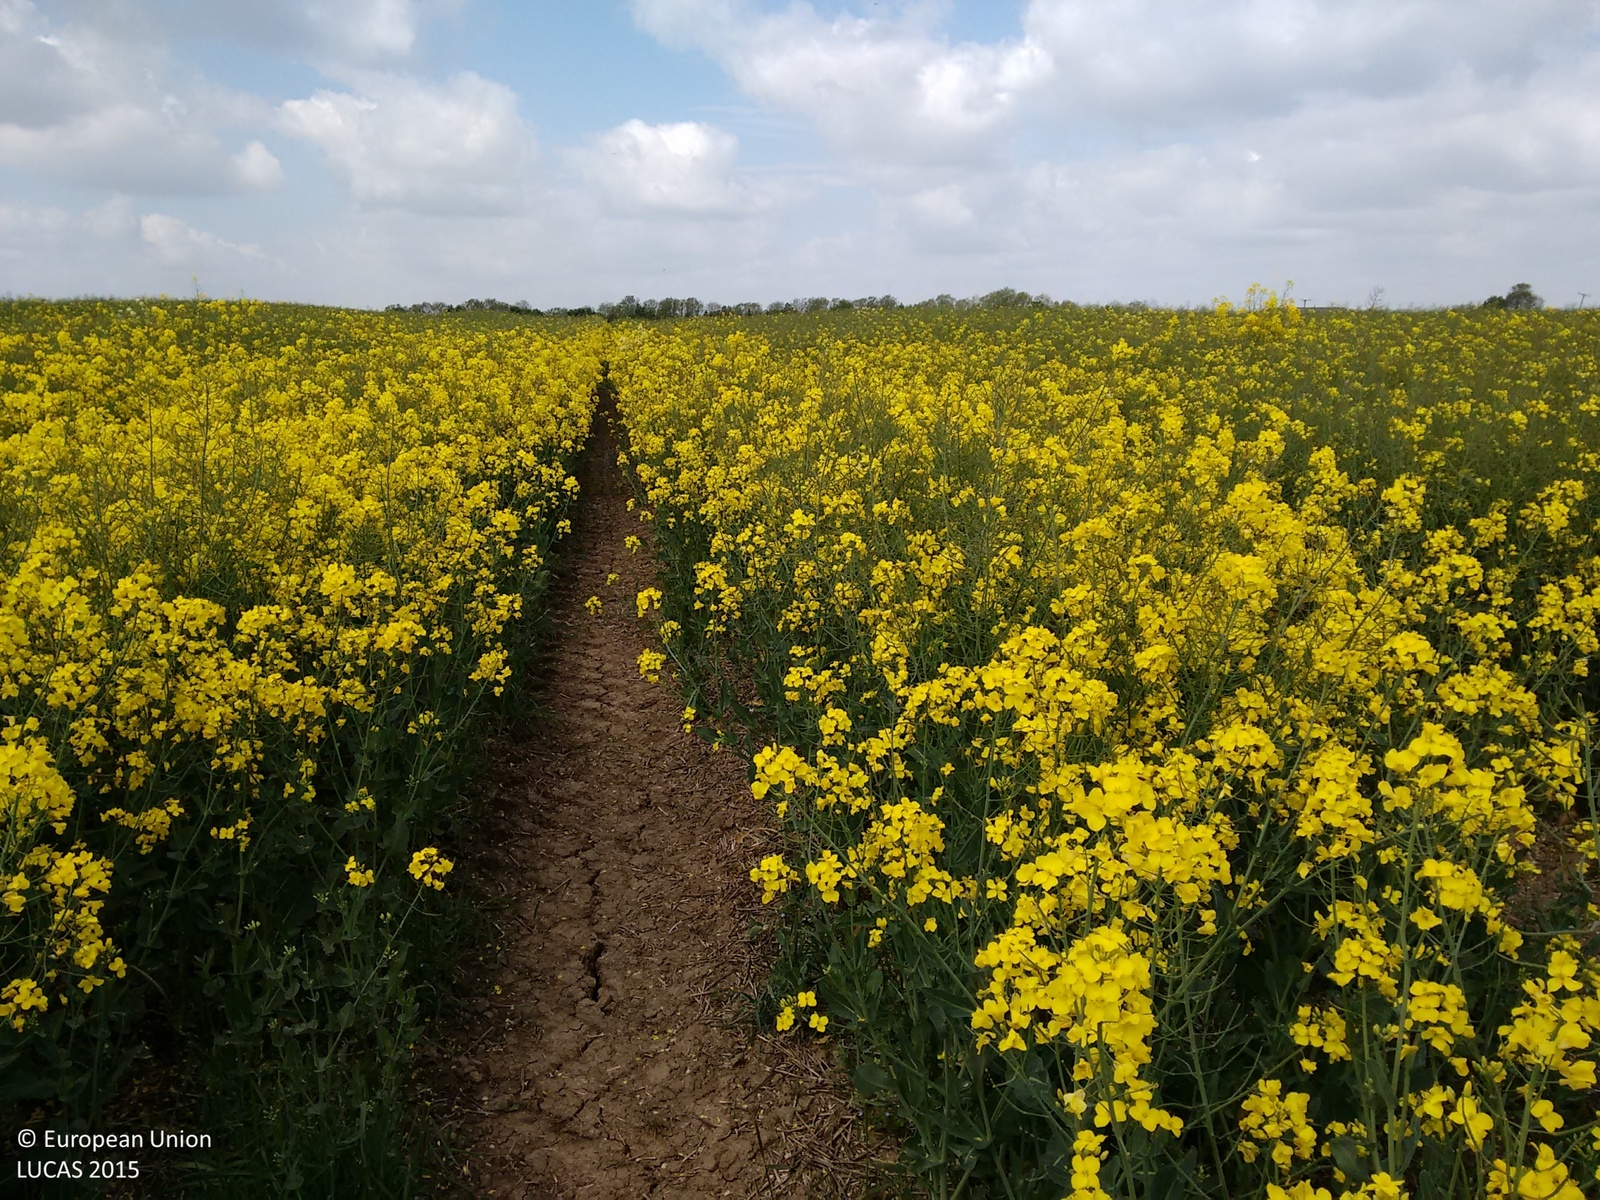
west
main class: Cropland
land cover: Rape and turnip rape
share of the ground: > 75 %
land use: Agriculture (excluding fallow land and kitchen gardens)
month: May
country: GB
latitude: 52.7260
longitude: -0.0872
